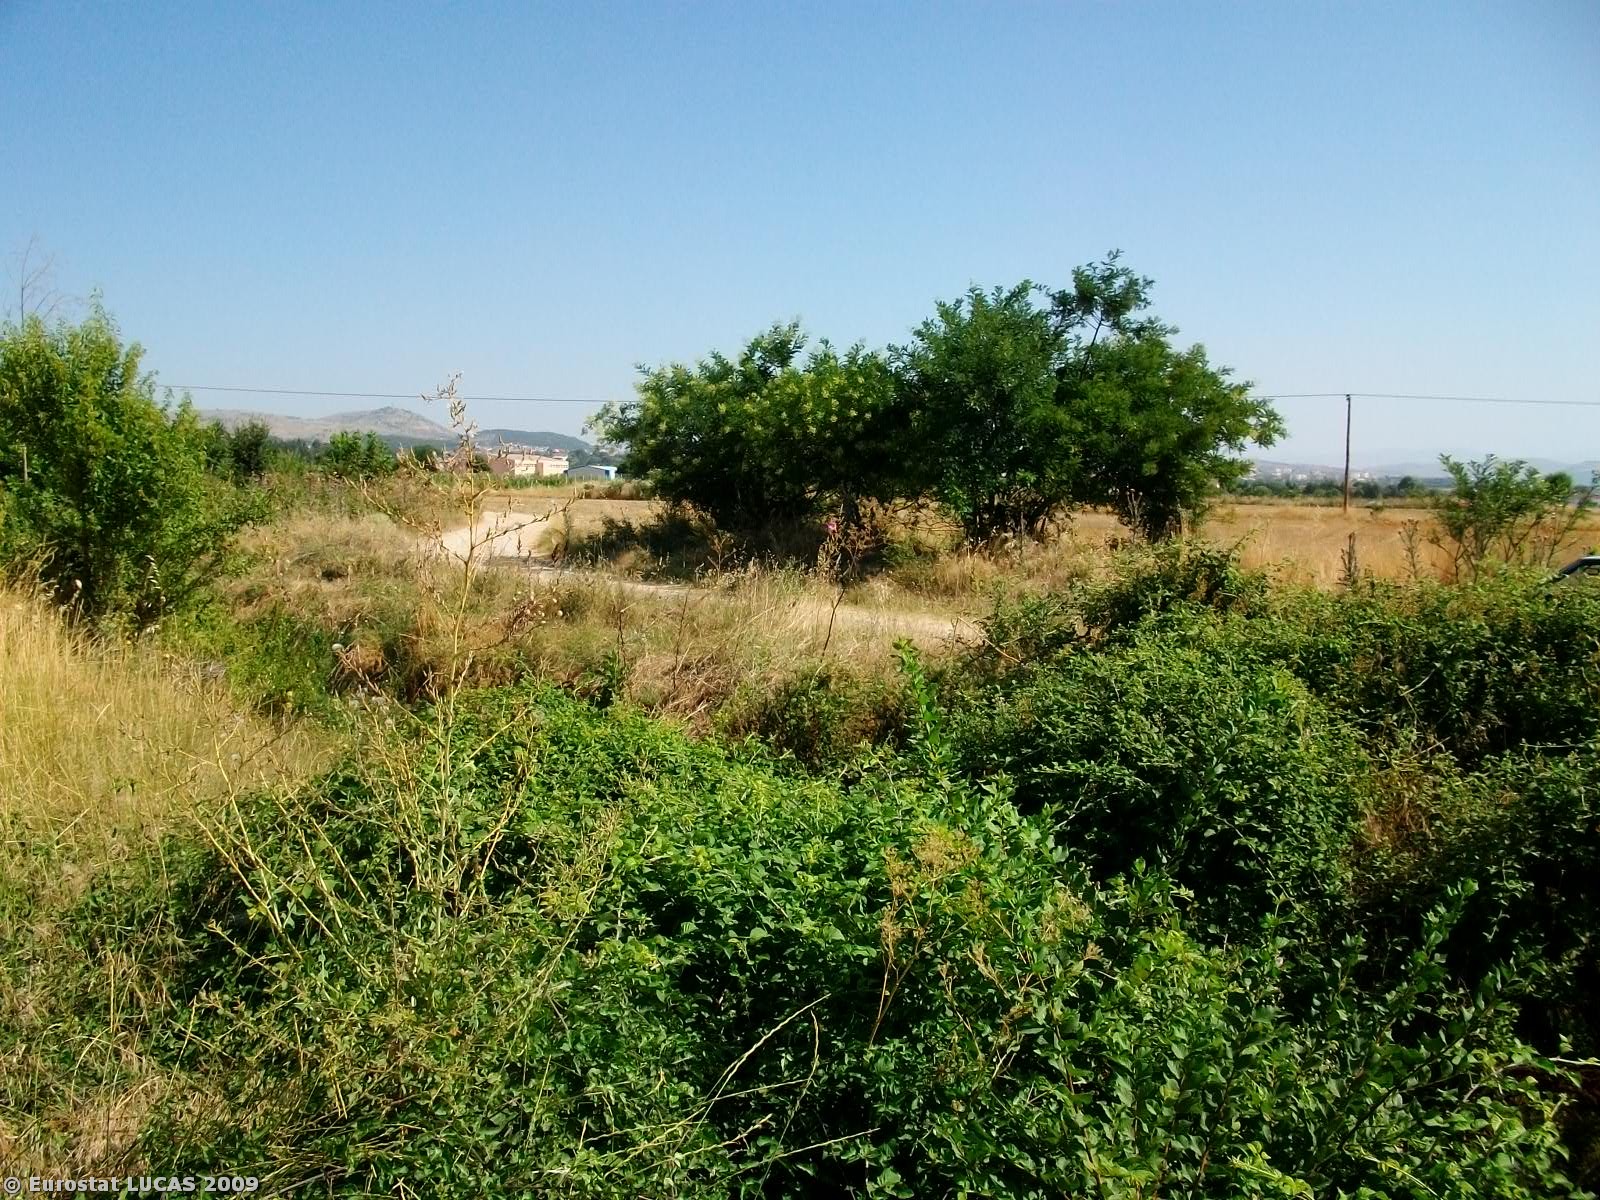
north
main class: Shrubland
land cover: Shrubland with sparse tree cover
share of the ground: > 75 %
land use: Unused
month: July
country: GR
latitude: 40.2666
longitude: 21.7858
